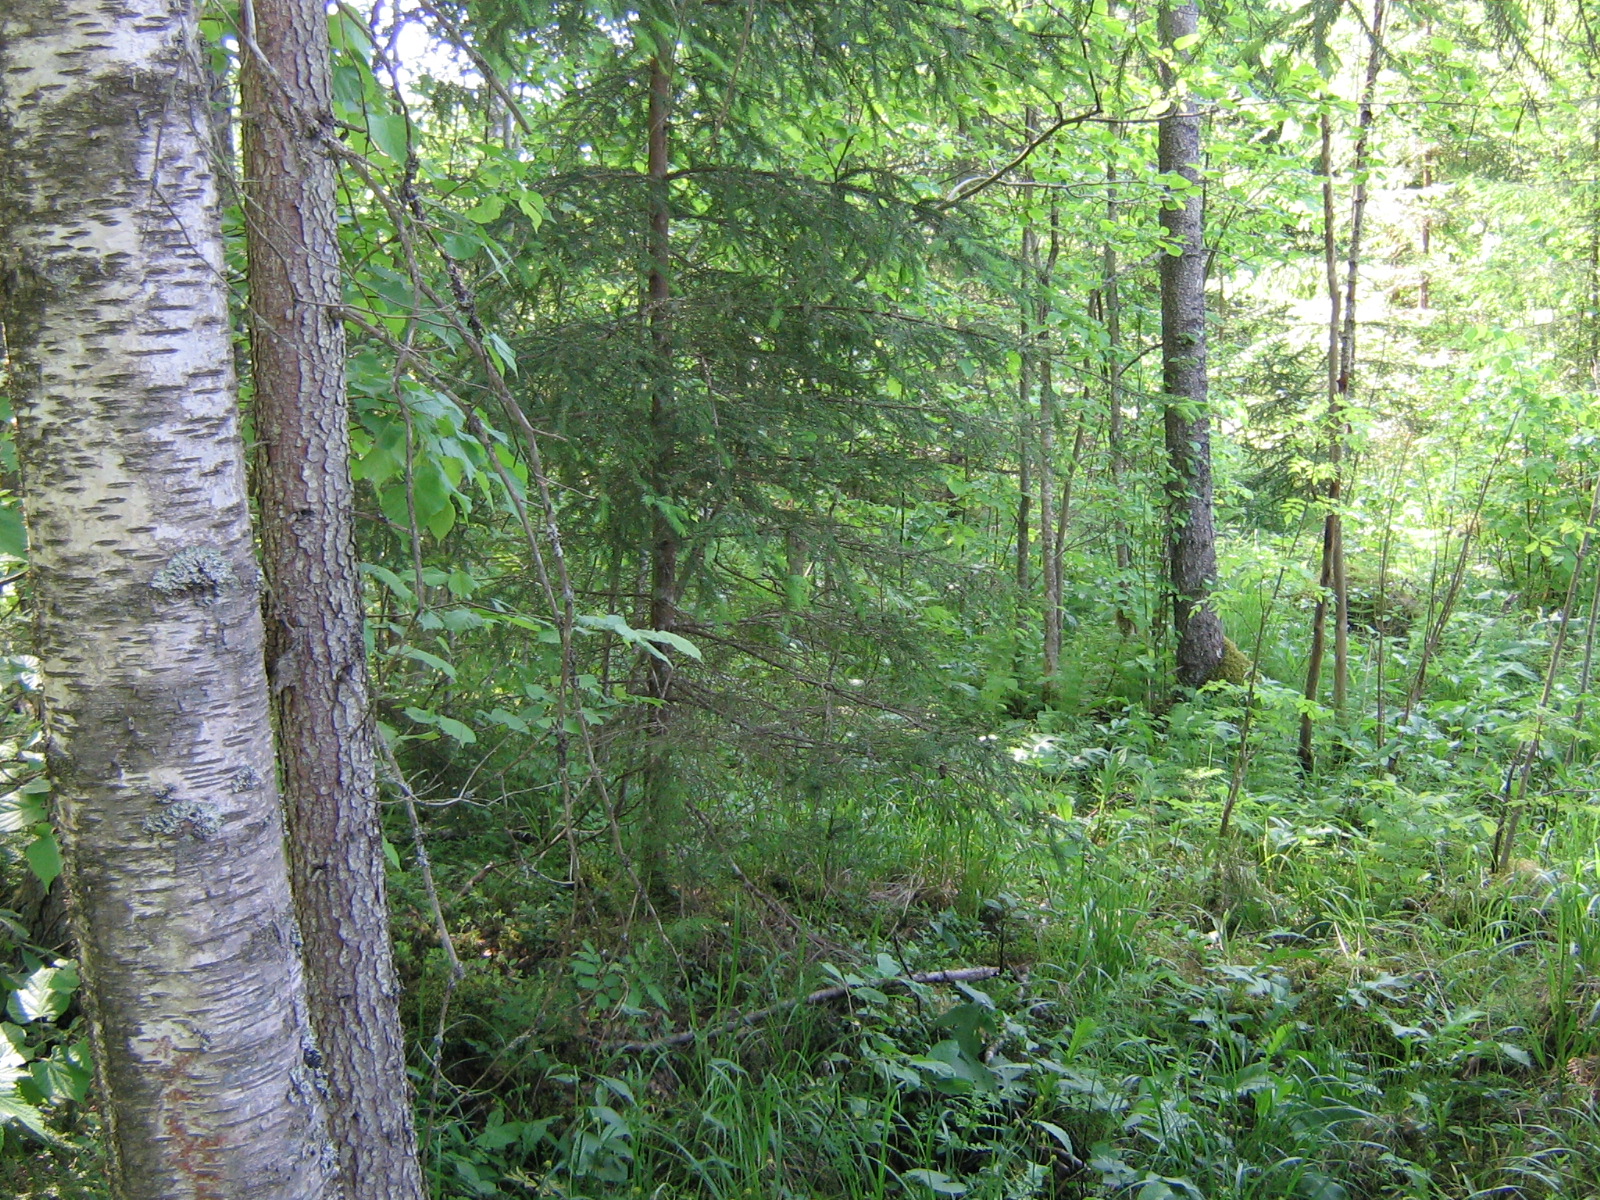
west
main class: Woodland
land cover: Spruce dominated mixed woodland
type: hemiboreal forest and nemoral coniferous forest and mixed broadleaved-coniferous forest
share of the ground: > 75 %
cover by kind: coniferous forest trees 65 %, broadleaved forest trees 35 %
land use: Forestry
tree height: > 5 m
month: June
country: LV
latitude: 56.8663
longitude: 25.3875
